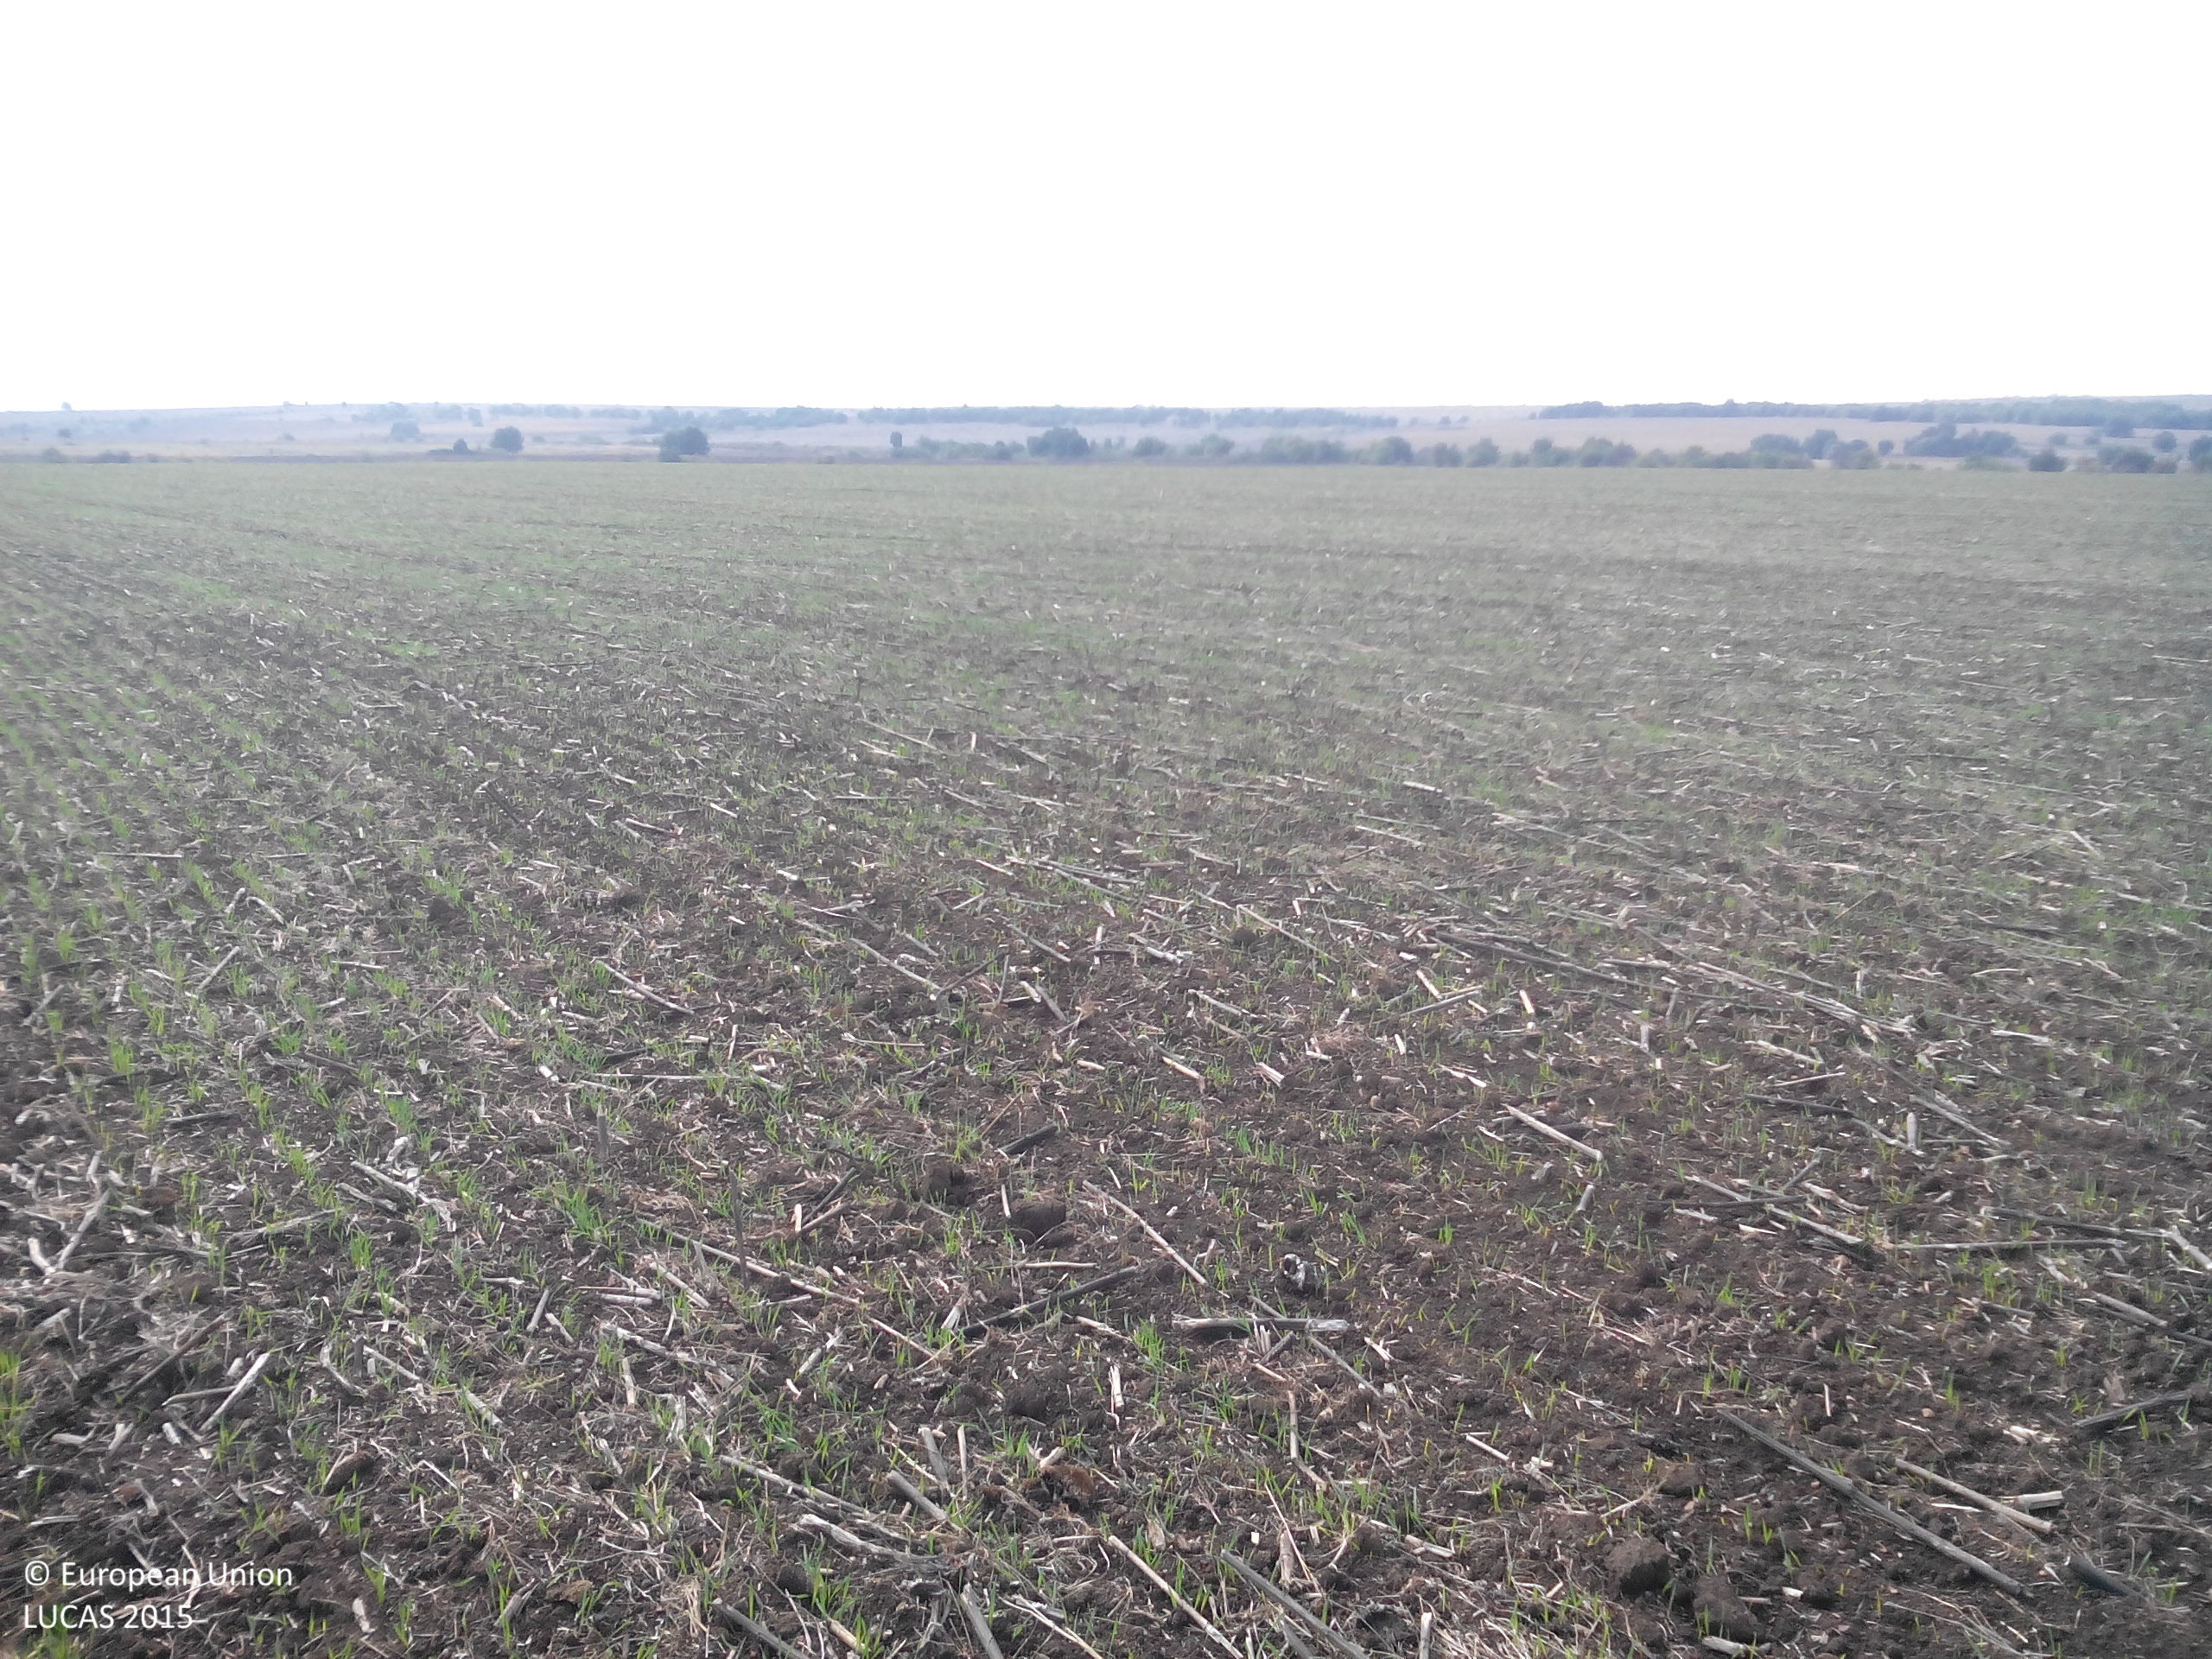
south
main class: Cropland
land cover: Common wheat
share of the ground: 10 - 25 %
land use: Agriculture (excluding fallow land and kitchen gardens)
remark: Harvested field
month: October
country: BG
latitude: 43.2026
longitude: 23.9438
